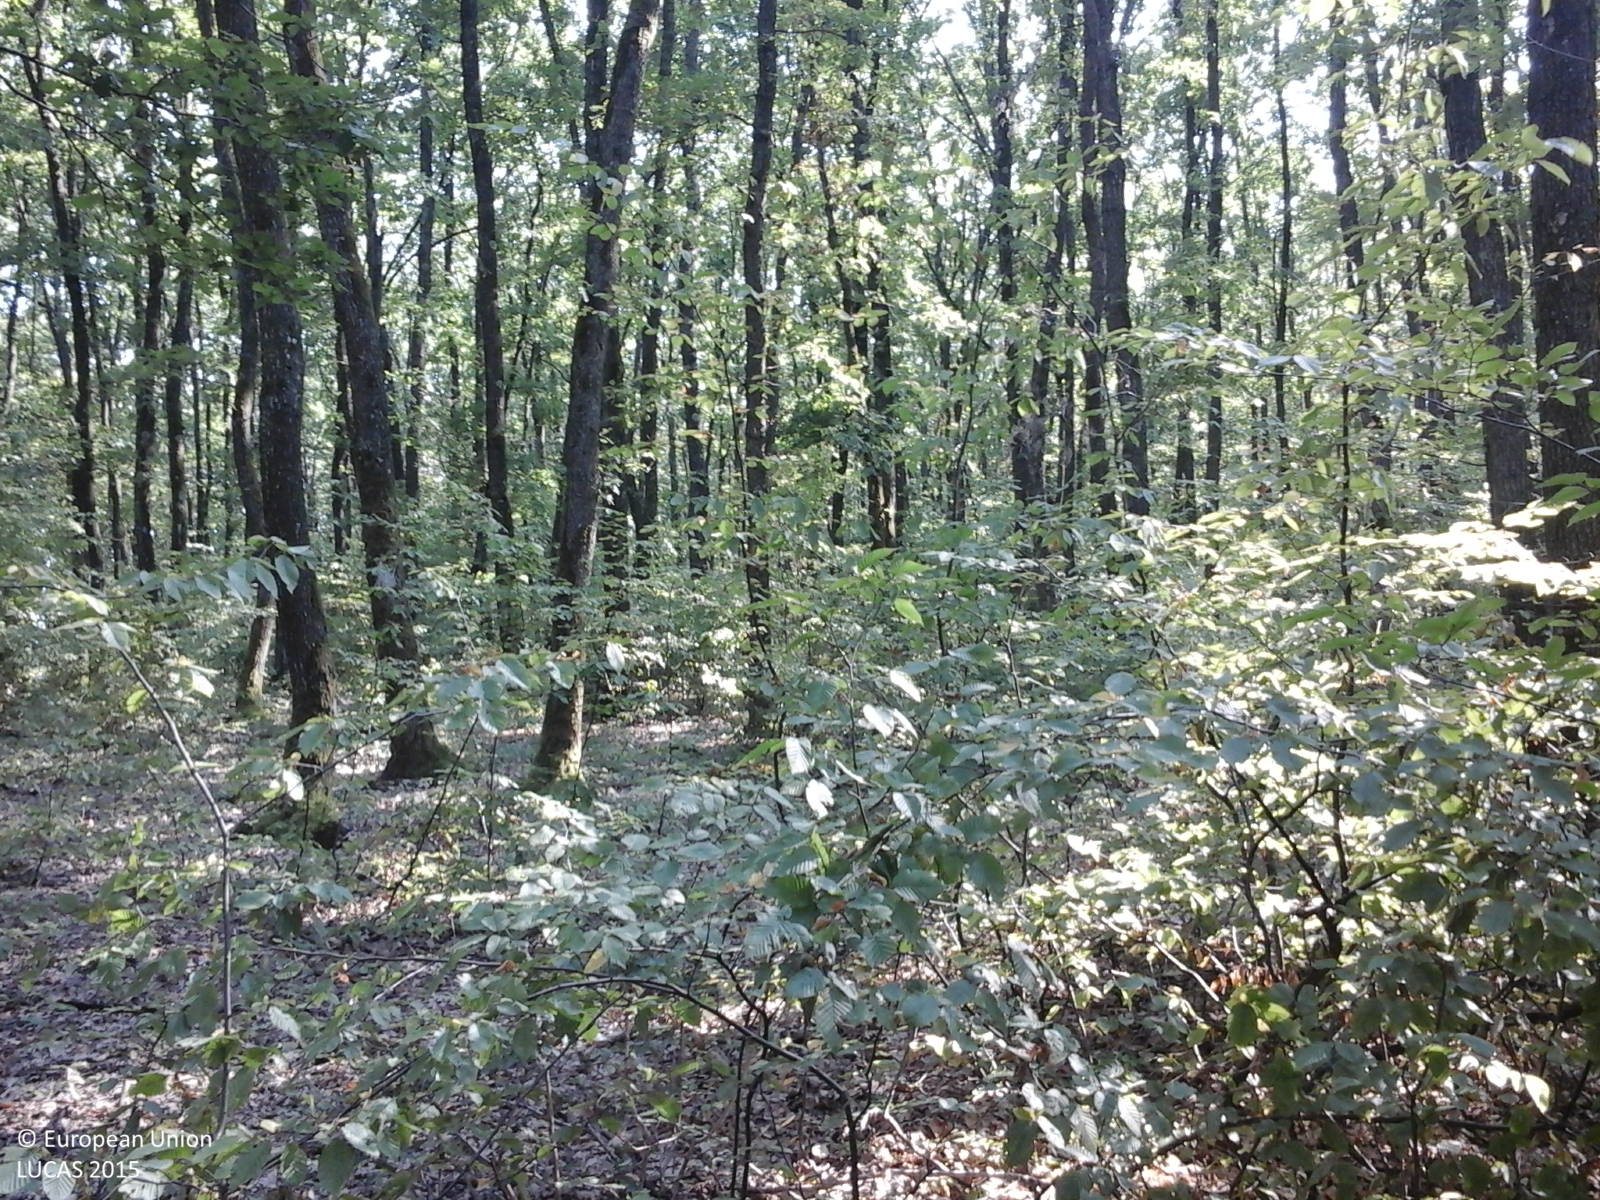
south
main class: Woodland
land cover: Broadleaved woodland
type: mesophytic deciduous forest
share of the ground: > 75 %
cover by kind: broadleaved forest trees 100 %
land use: Forestry
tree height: > 5 m
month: September
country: RO
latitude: 47.1441
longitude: 24.2618
